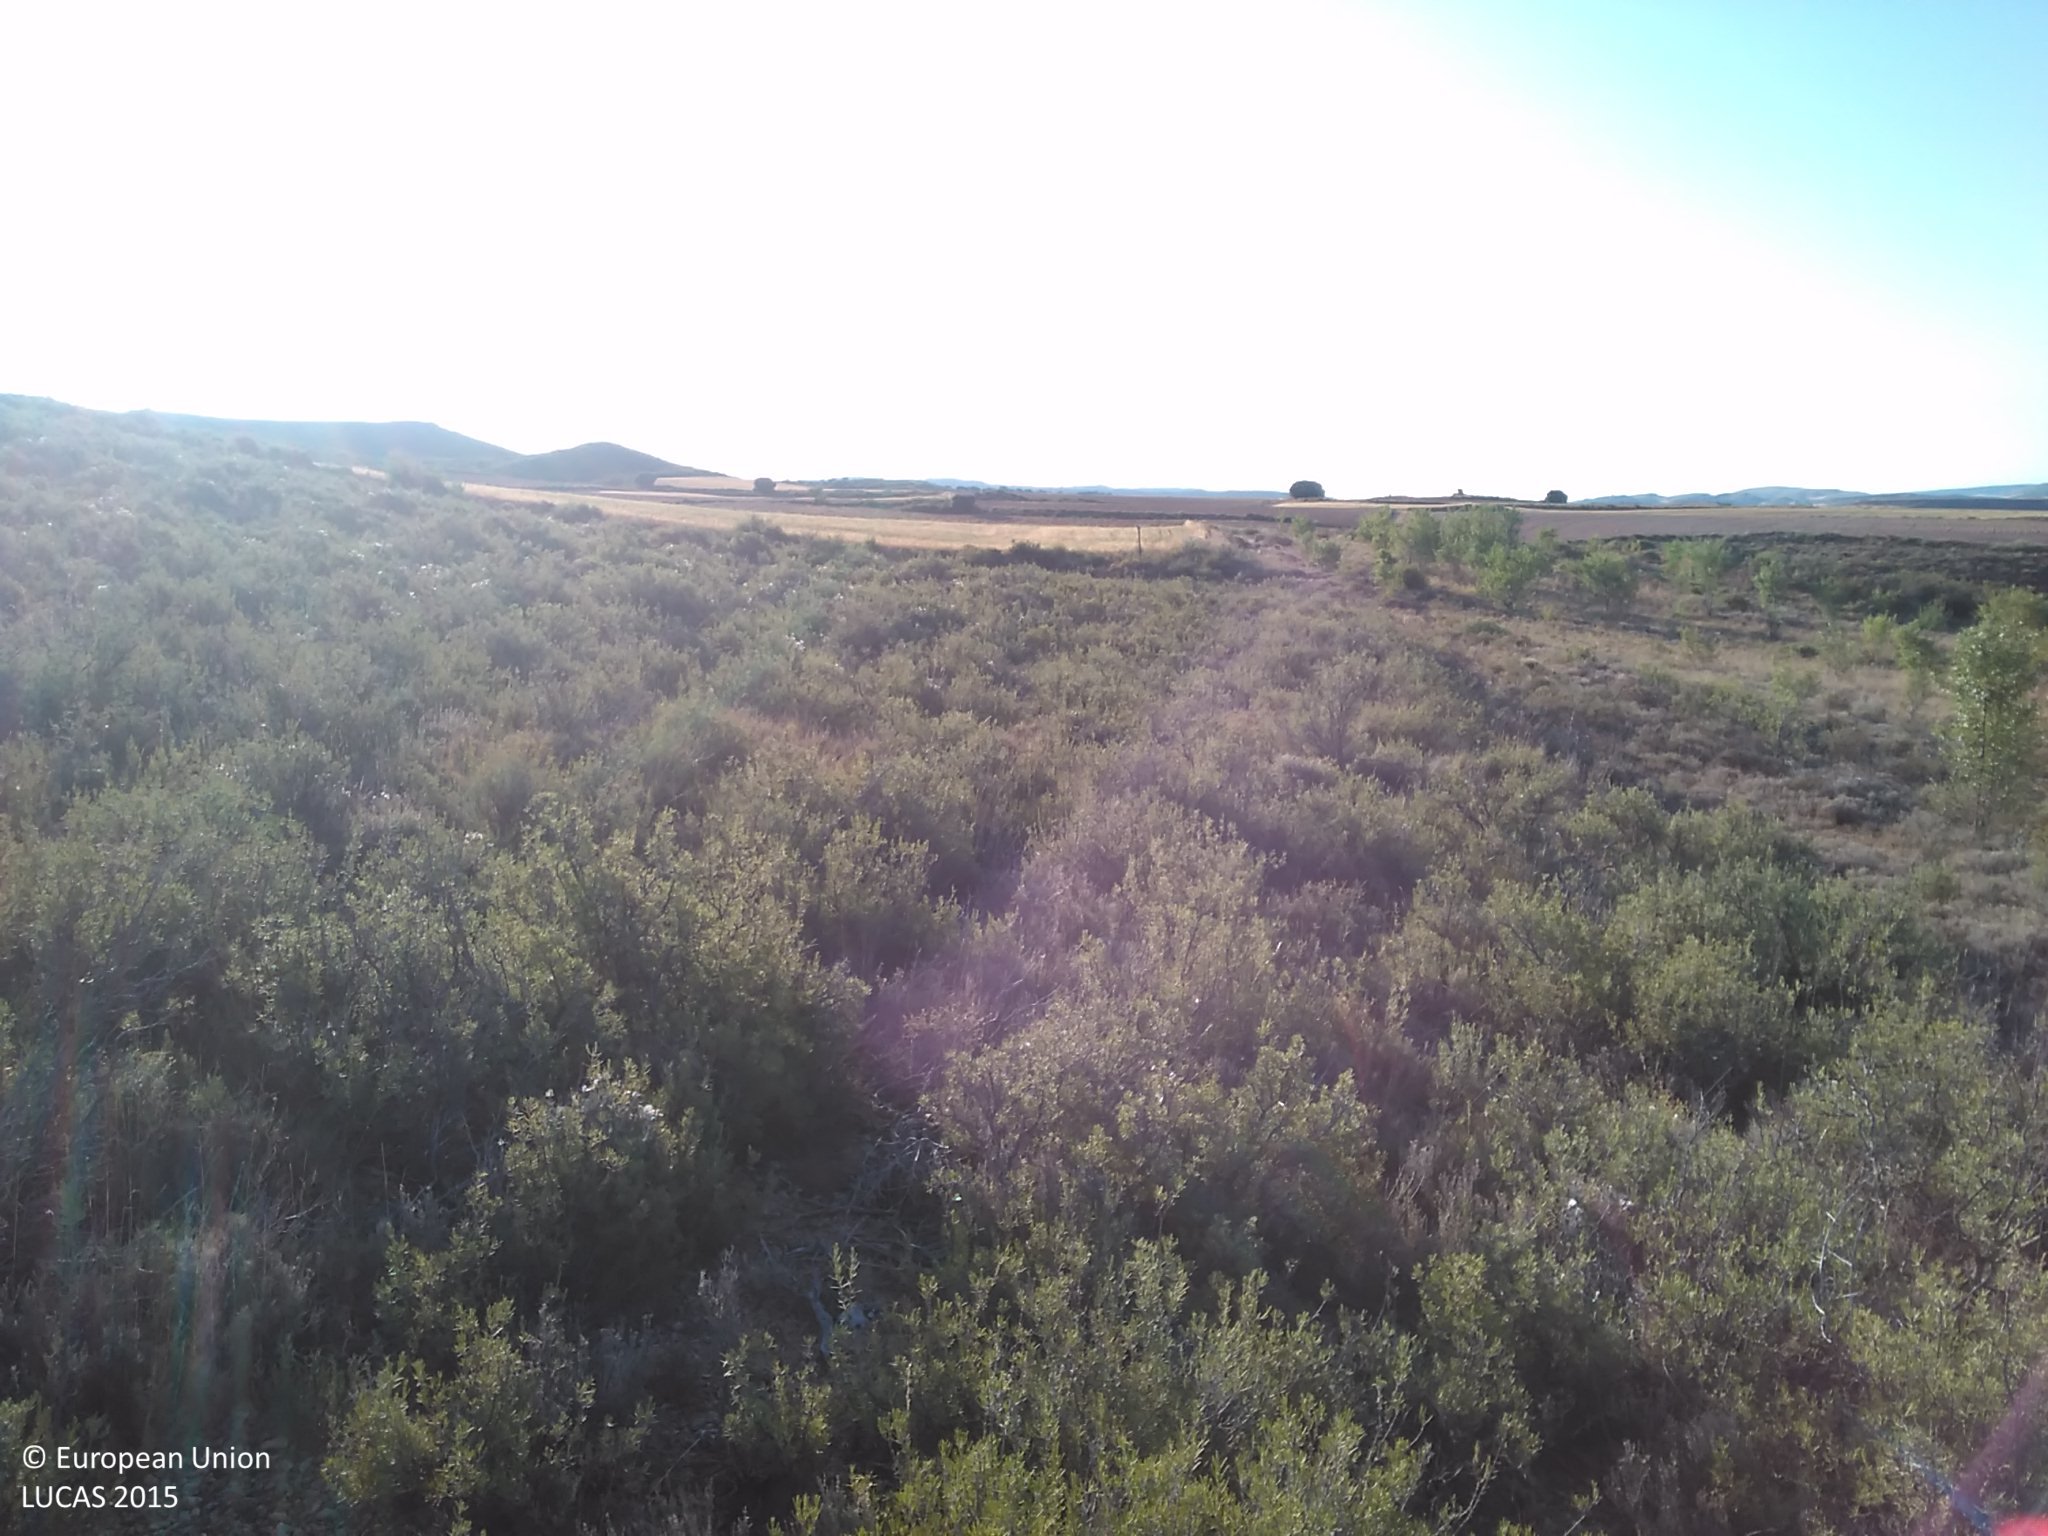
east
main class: Shrubland
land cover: Shrubland without tree cover
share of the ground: 50 - 75 %
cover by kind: shrubs 60 %, unconsolidated bare surface 35 %, herbaceous plants 5 %
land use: Semi-natural and natural areas not in use
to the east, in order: Shrubland without tree cover; Barley; Shrubland without tree cover; Spontaneously vegetated surfaces
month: July
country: ES
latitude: 41.4801
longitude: -2.1632
